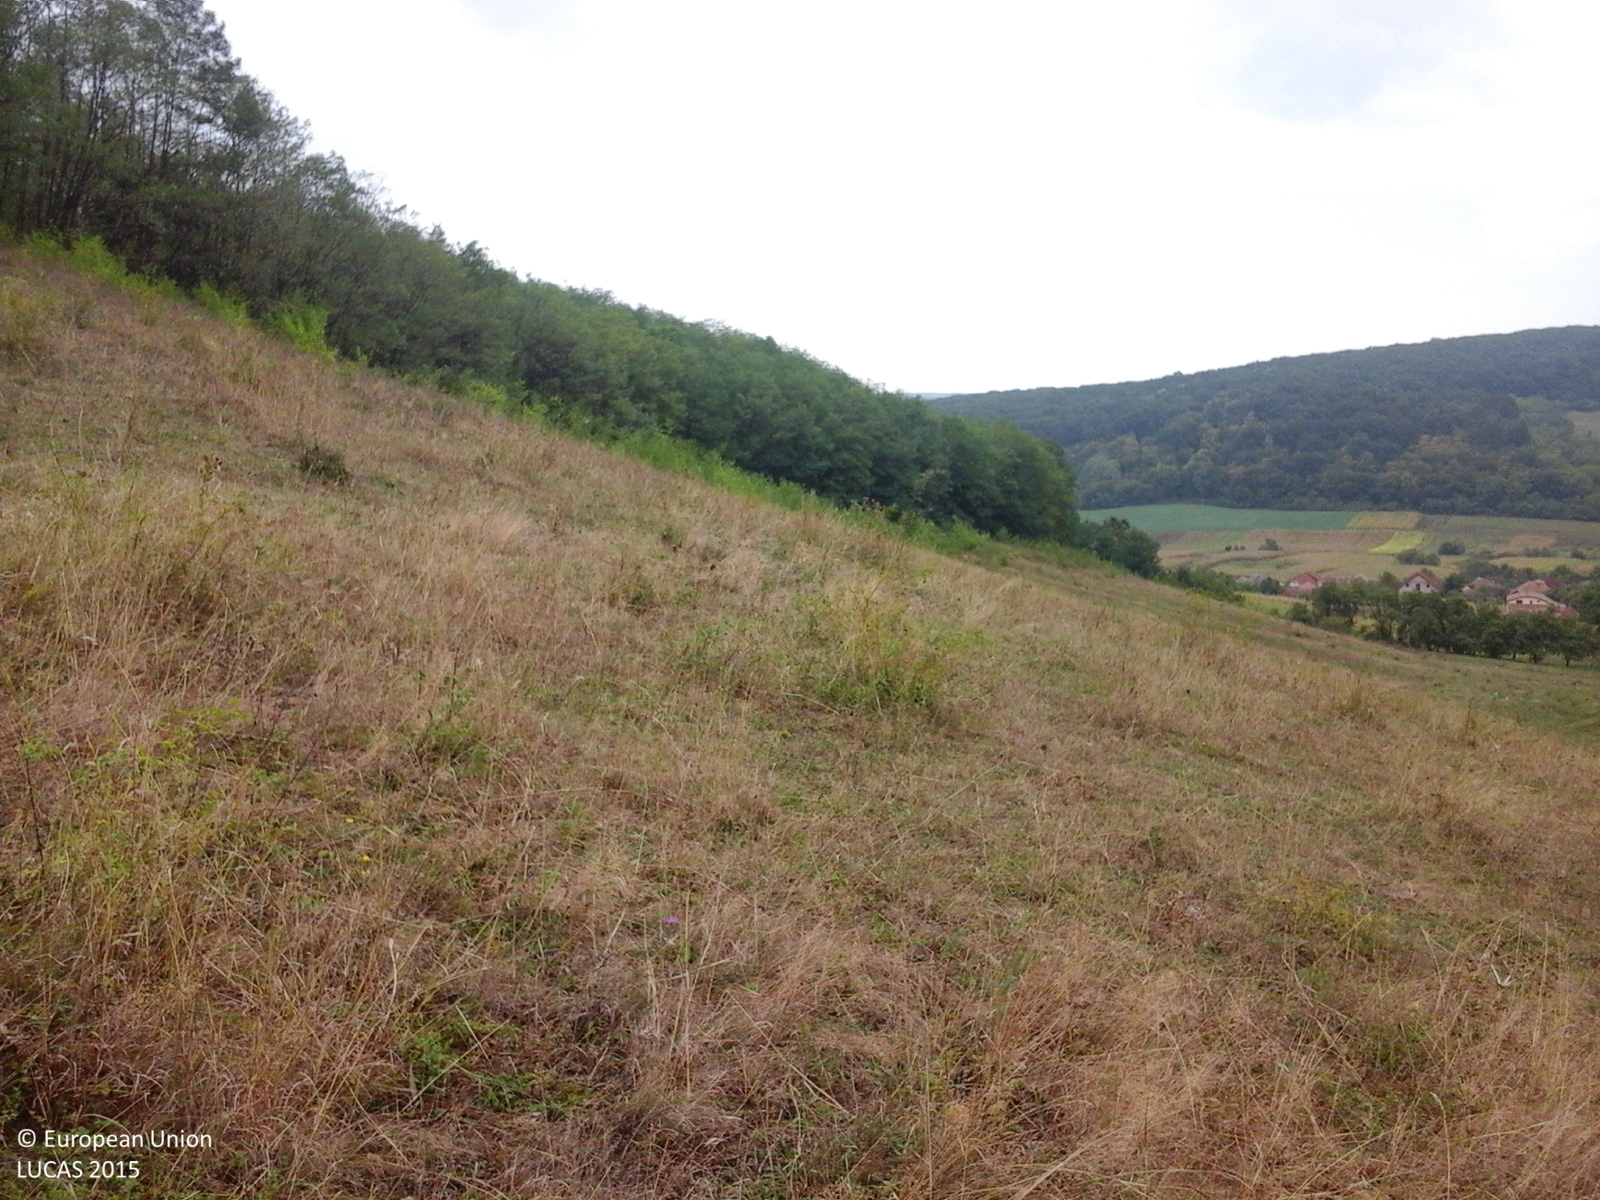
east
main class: Grassland
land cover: Grassland without tree/shrub cover
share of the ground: > 75 %
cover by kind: herbaceous plants 100 %
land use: Agriculture (excluding fallow land and kitchen gardens)
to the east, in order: Grassland without tree/shrub cover; Grassland with sparse tree/shrub cover; Broadleaved woodland
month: September
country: RO
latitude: 47.2141
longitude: 22.9899
